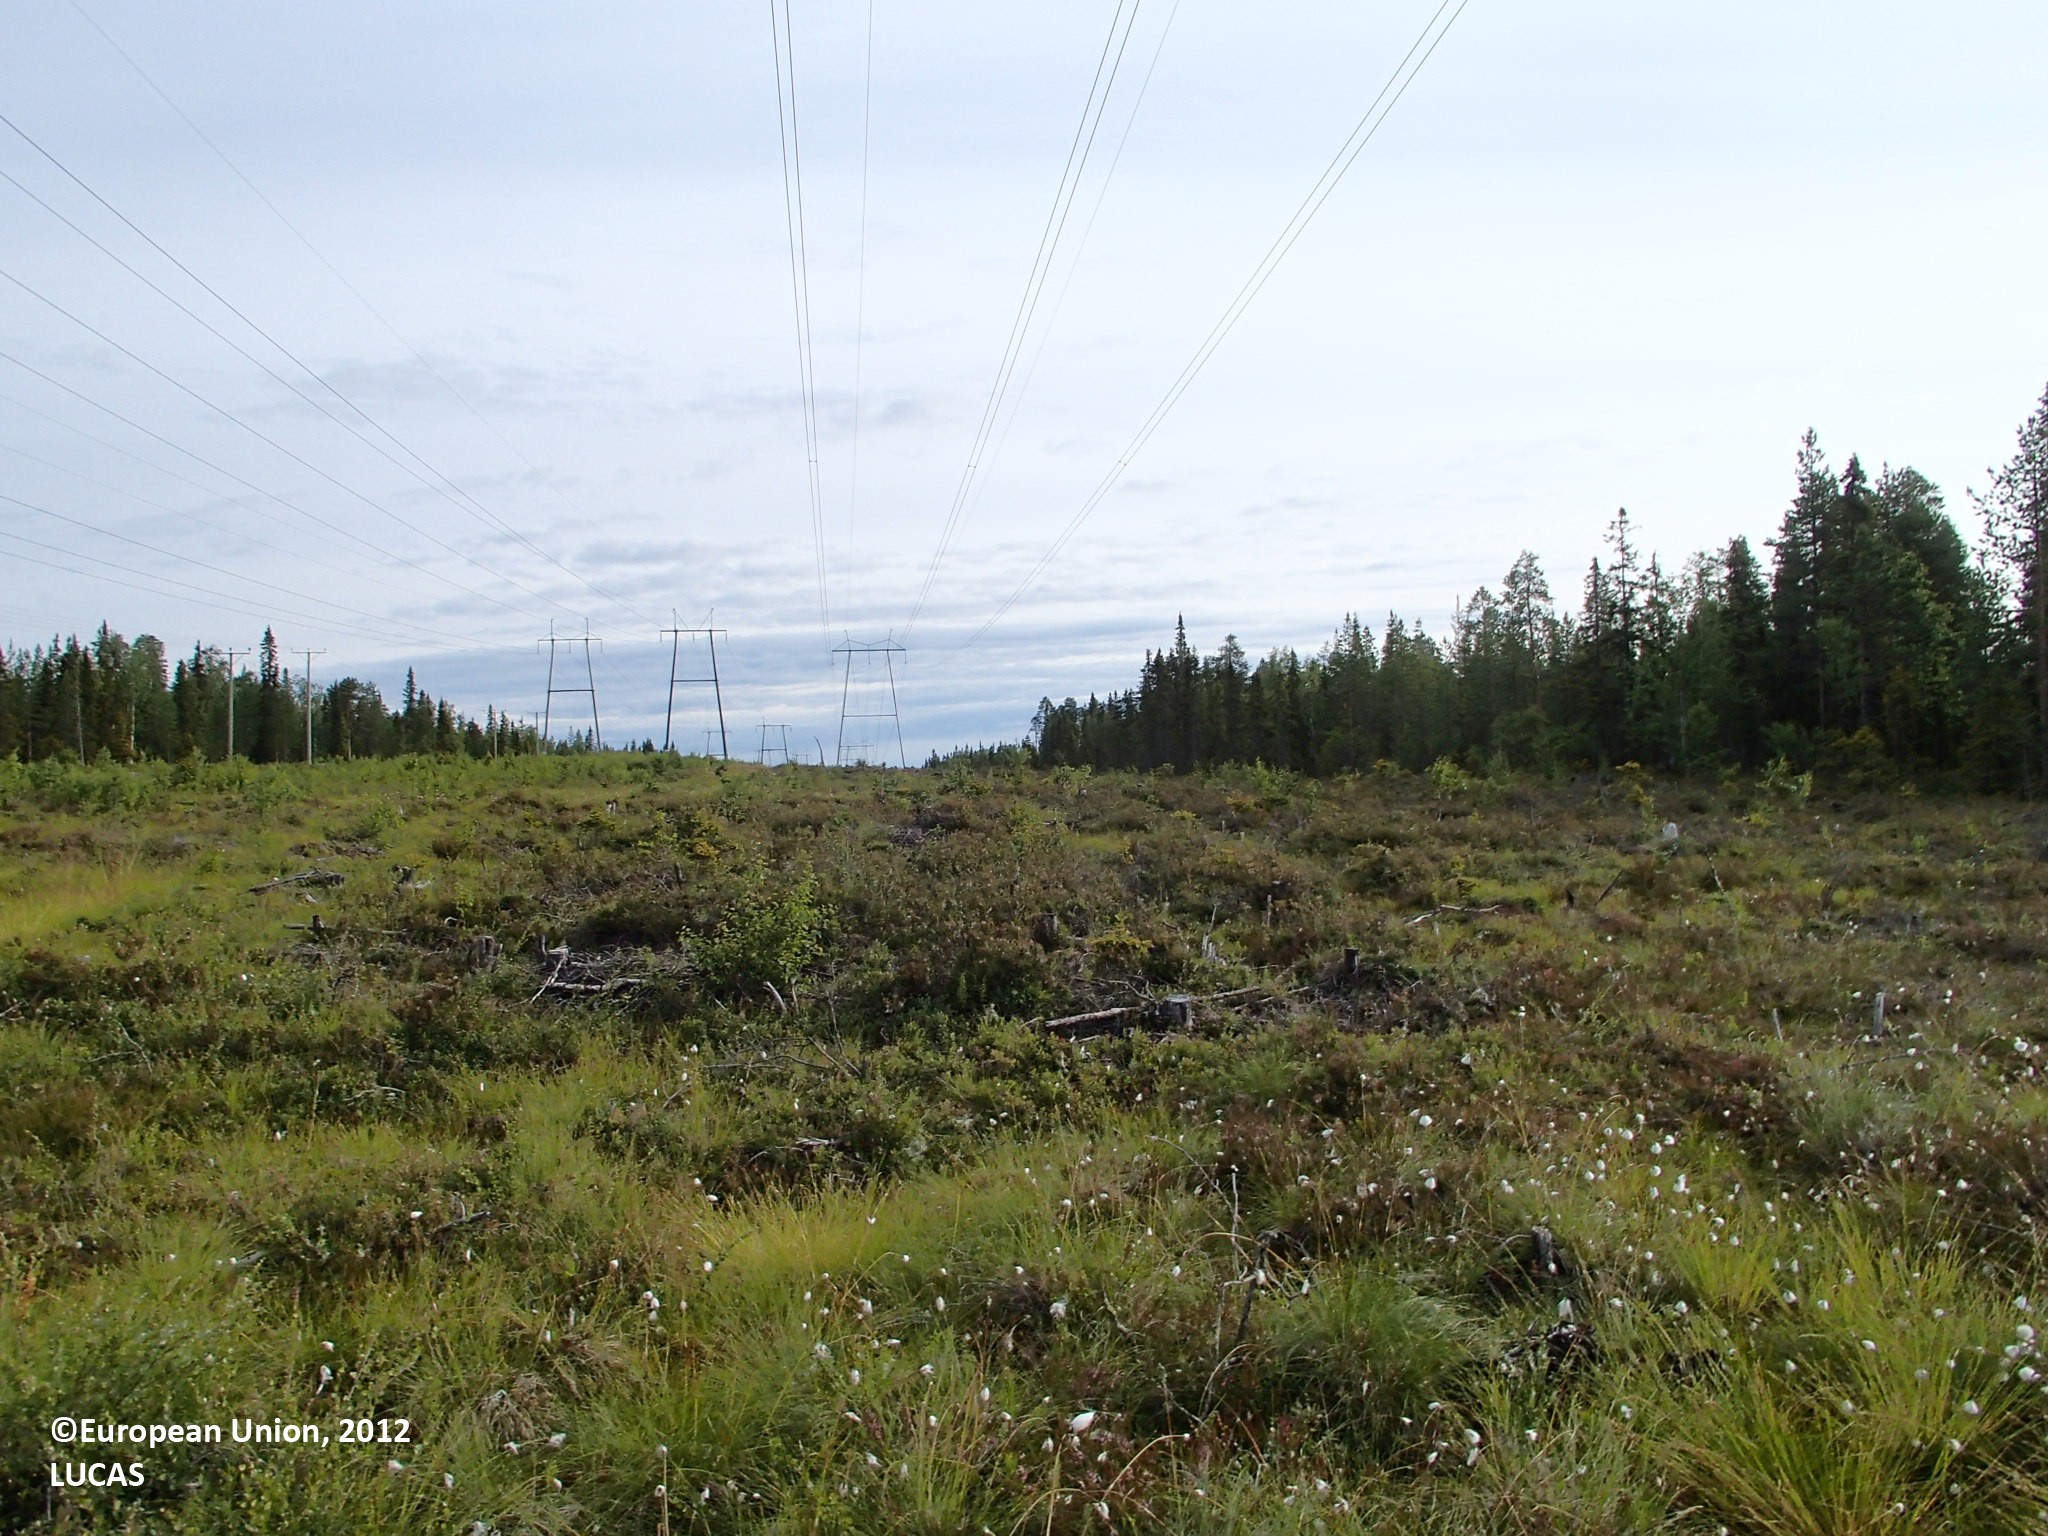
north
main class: Grassland
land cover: Grassland with sparse tree/shrub cover
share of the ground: > 75 %
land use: Energy production
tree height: < 5 m
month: July
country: FI
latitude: 66.4382
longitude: 25.5571
